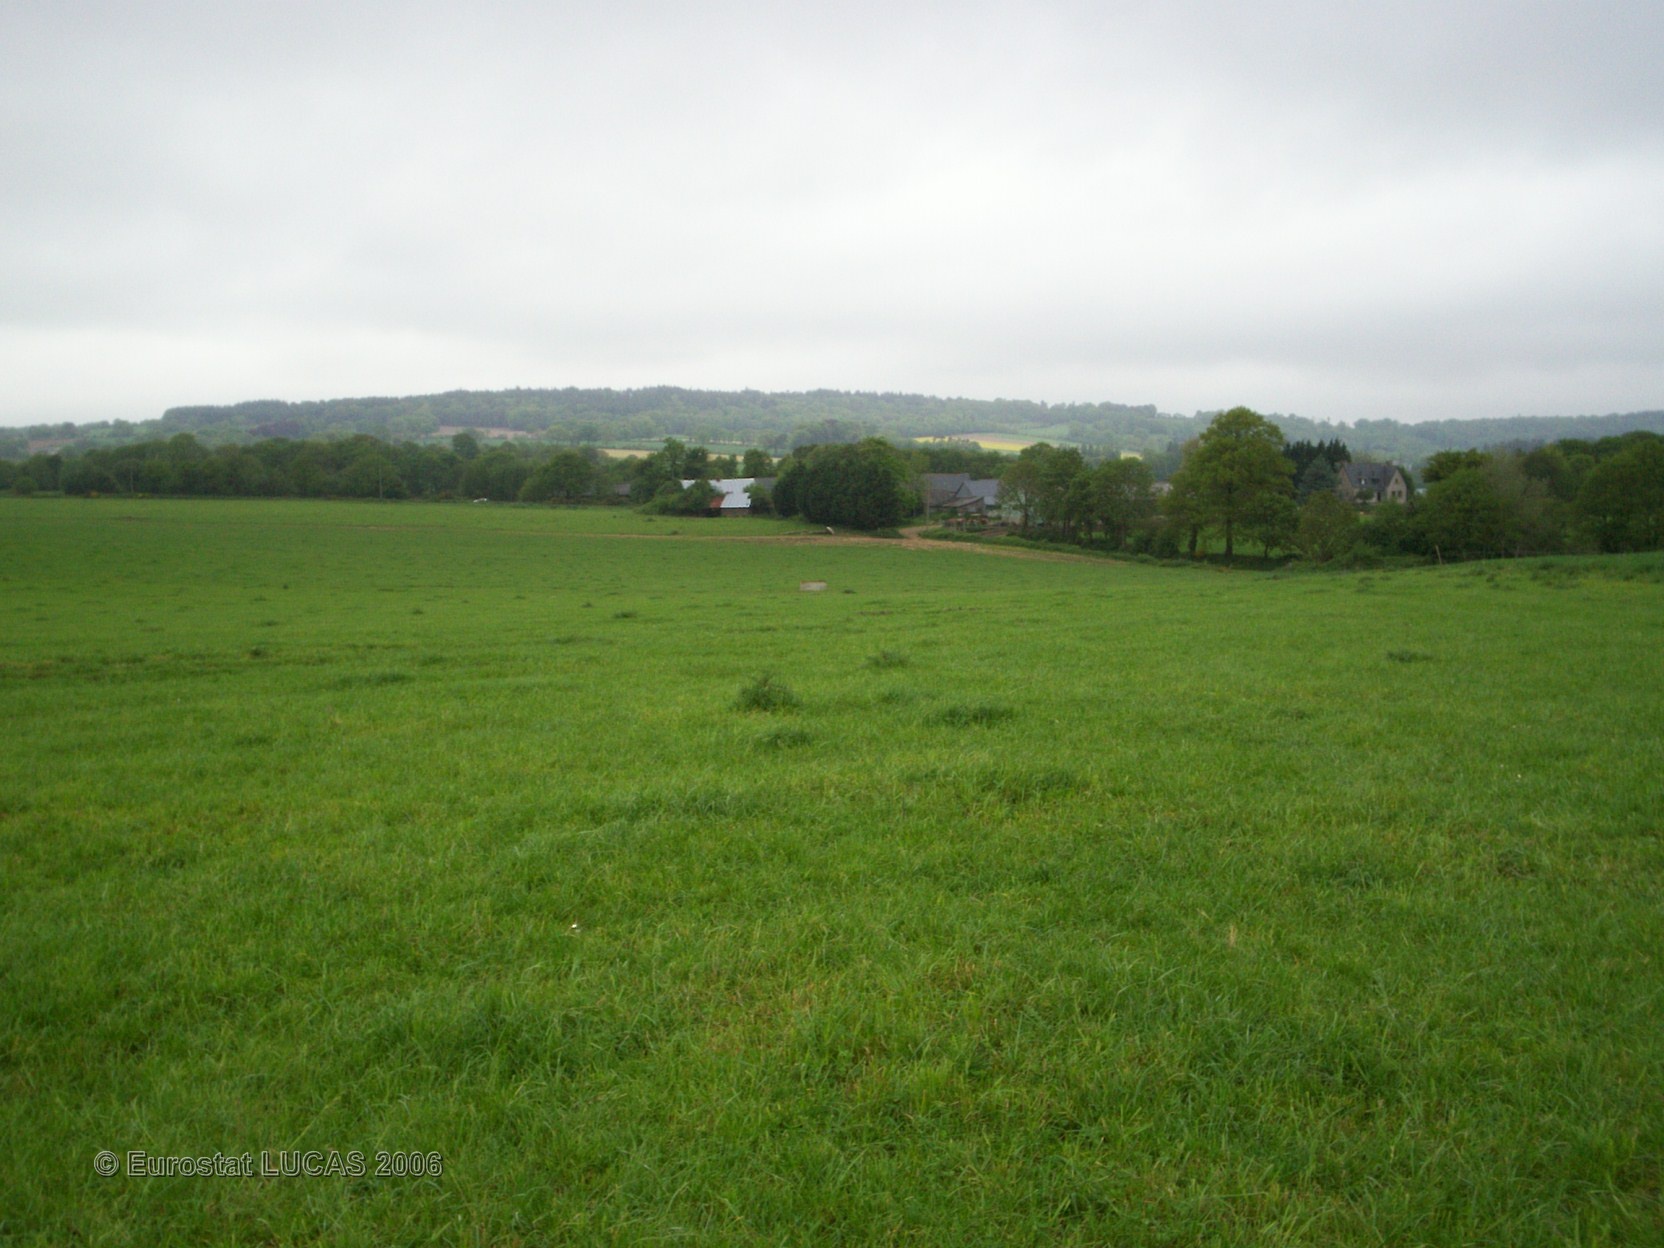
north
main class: Grassland
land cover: Grassland without tree/shrub cover
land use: Agriculture (excluding fallow land and kitchen gardens)
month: May
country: FR
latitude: 48.2275
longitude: -2.8961
